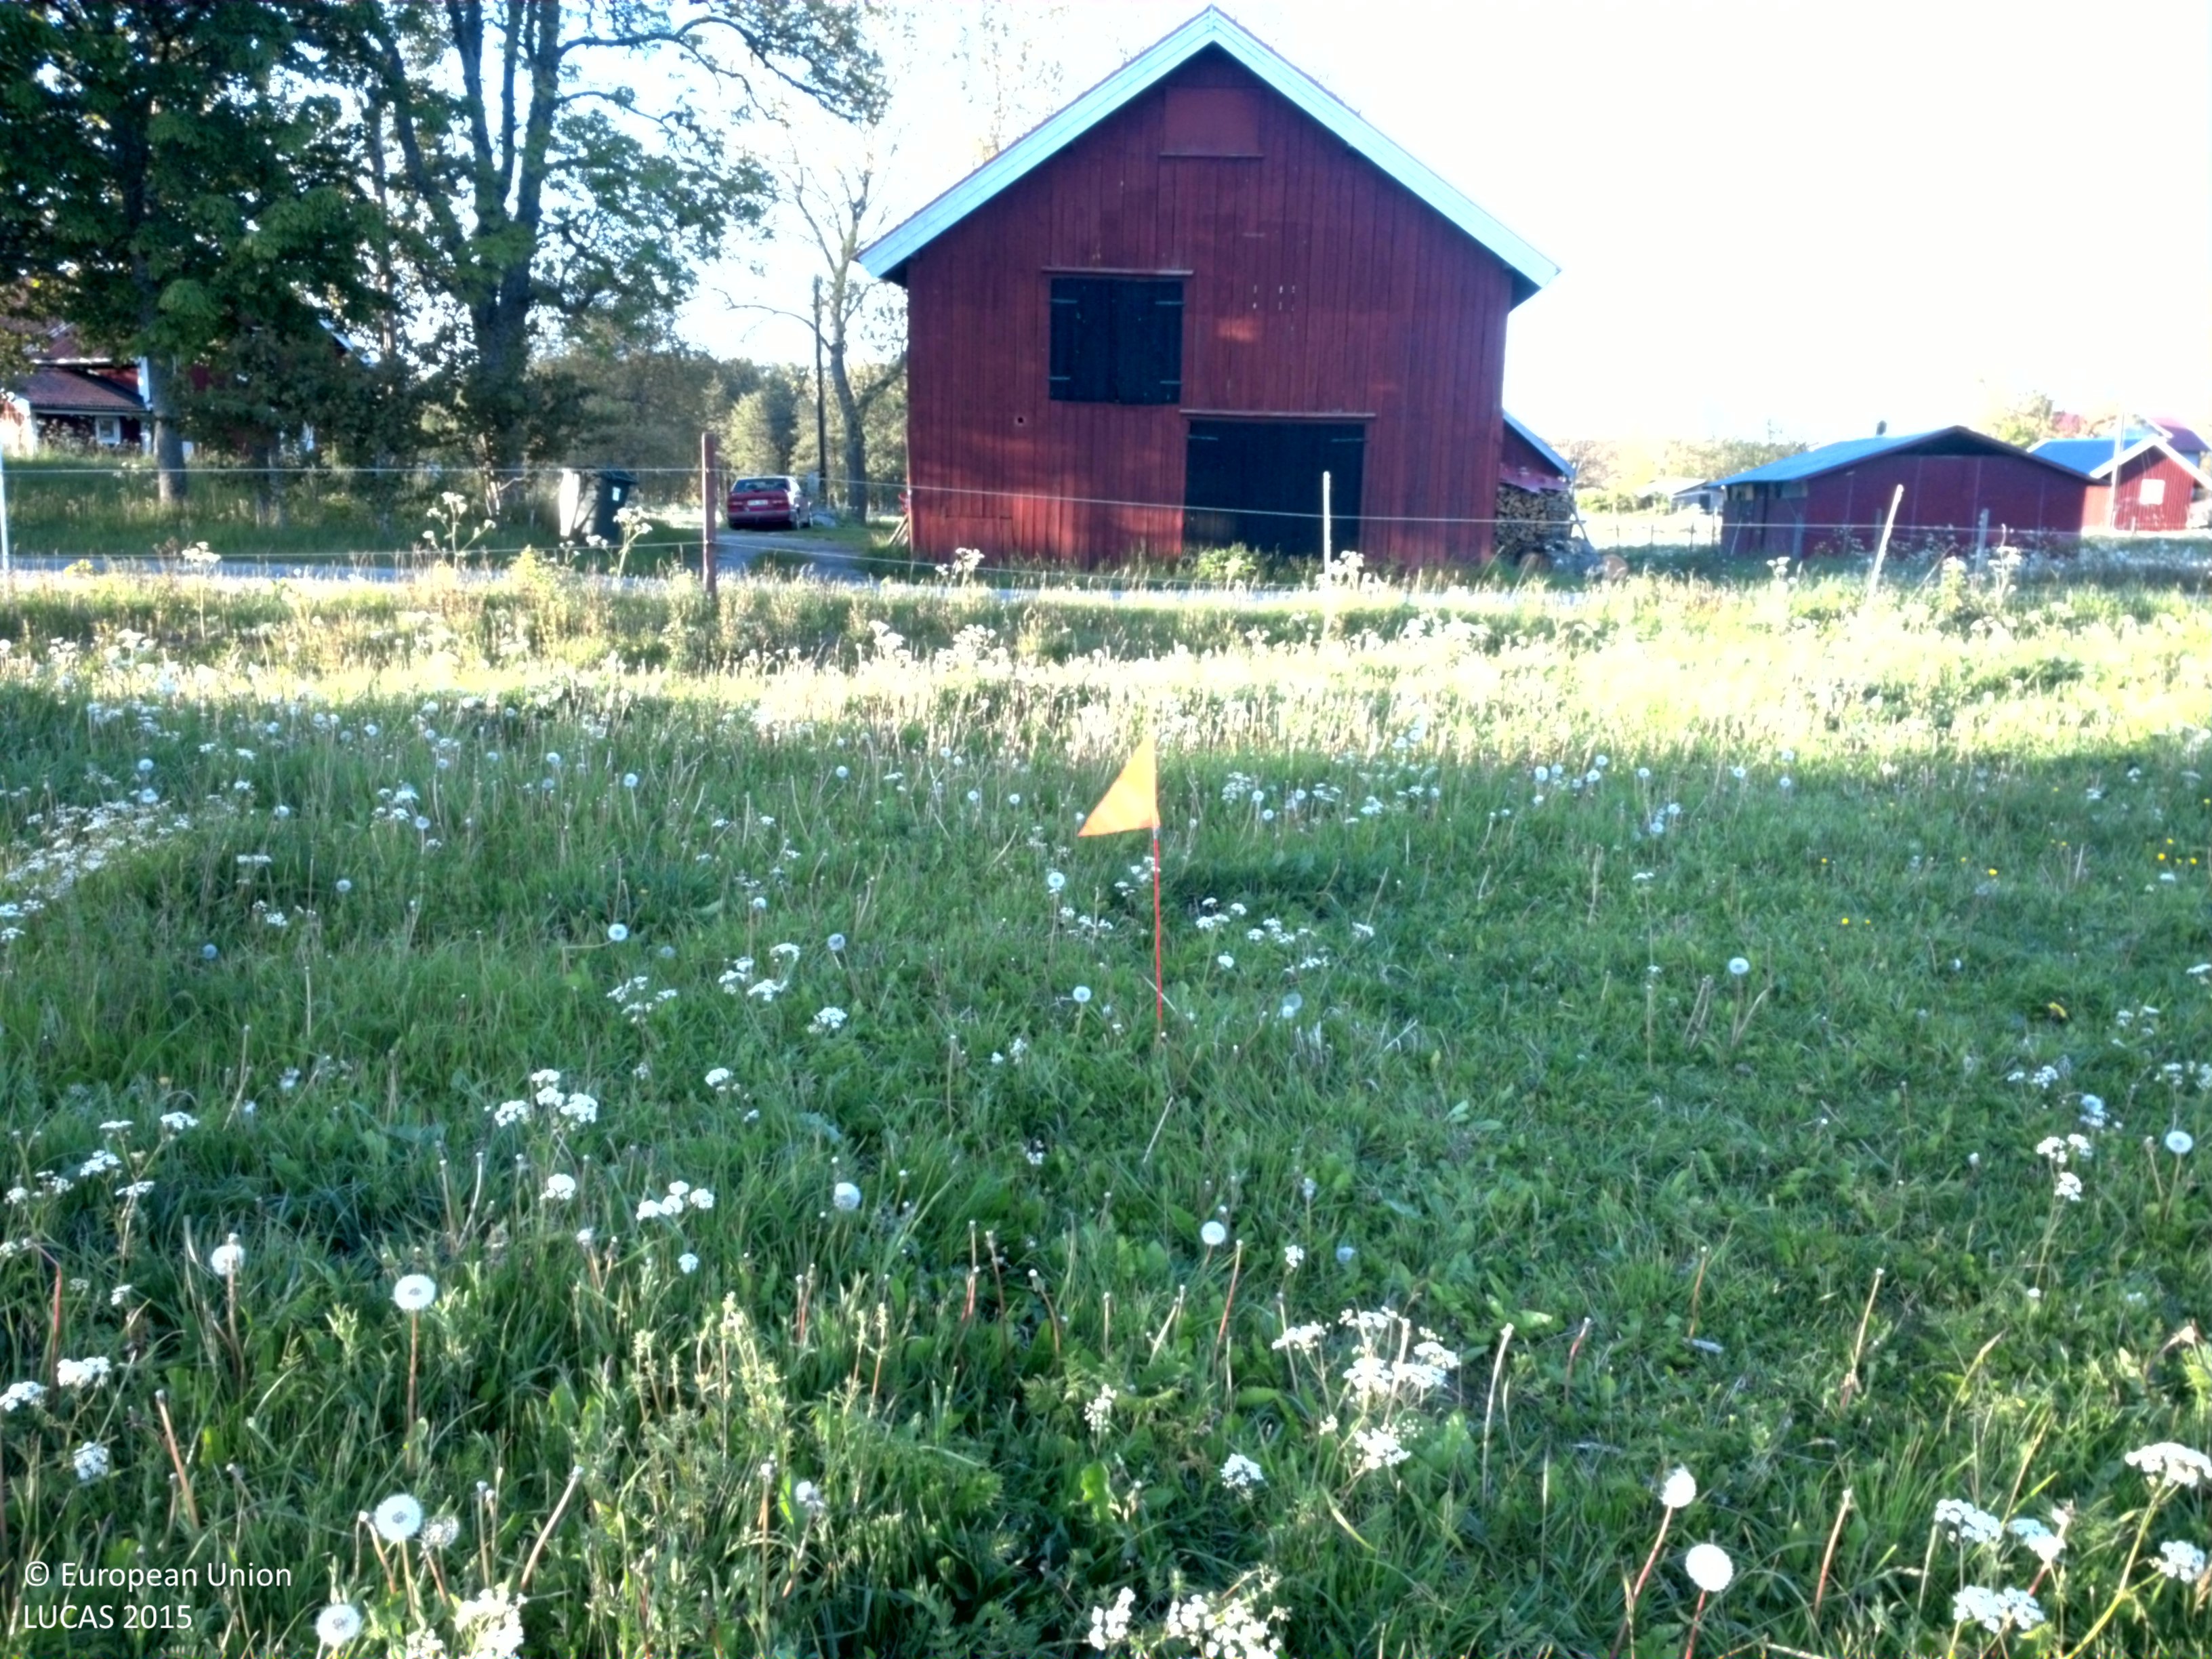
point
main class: Grassland
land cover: Grassland without tree/shrub cover
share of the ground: > 75 %
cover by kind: herbaceous plants 85 %, lichens and mosses 10 %, shrubs 5 %
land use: Agriculture (excluding fallow land and kitchen gardens)
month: June
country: SE
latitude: 60.1609
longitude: 18.7729
